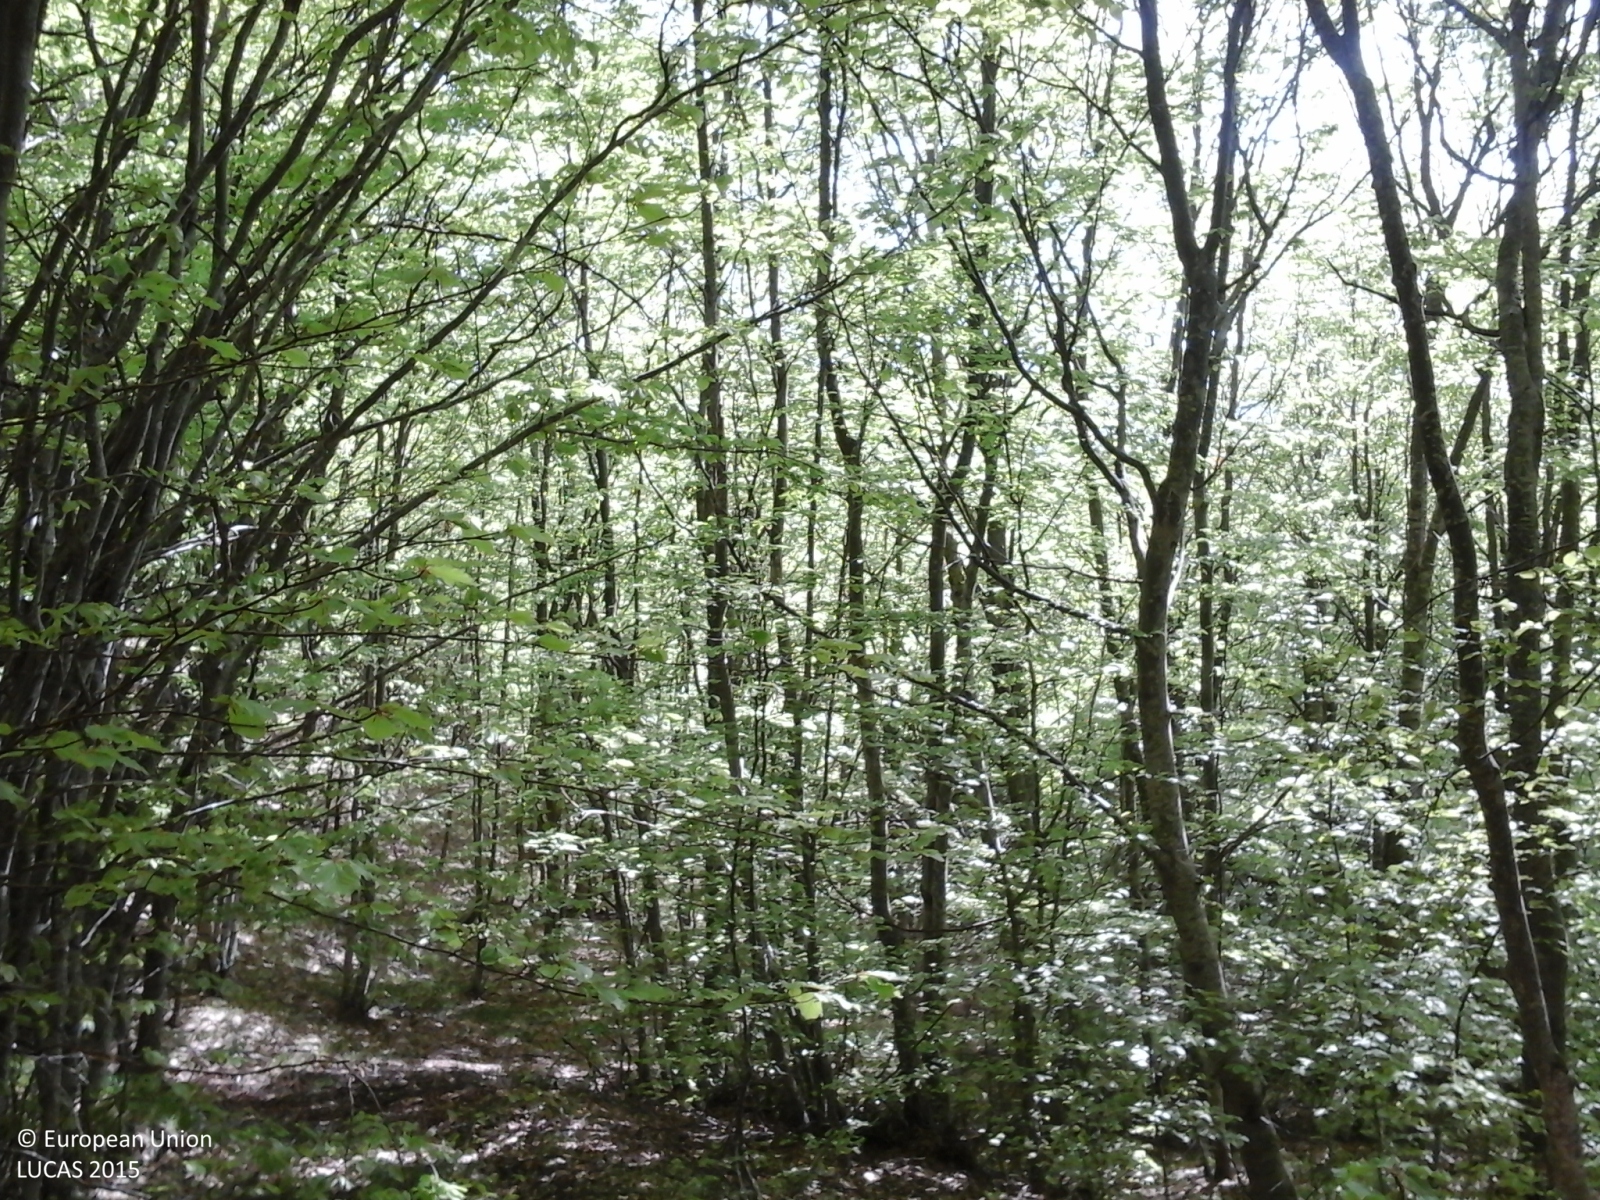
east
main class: Woodland
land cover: Broadleaved woodland
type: mountainous beech forest
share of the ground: > 75 %
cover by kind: broadleaved forest trees 100 %
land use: Forestry
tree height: > 5 m
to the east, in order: Broadleaved woodland; Tracks; Broadleaved woodland; Grassland with sparse tree/shrub cover; Broadleaved woodland
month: May
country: IT
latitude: 44.6722
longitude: 9.2070
